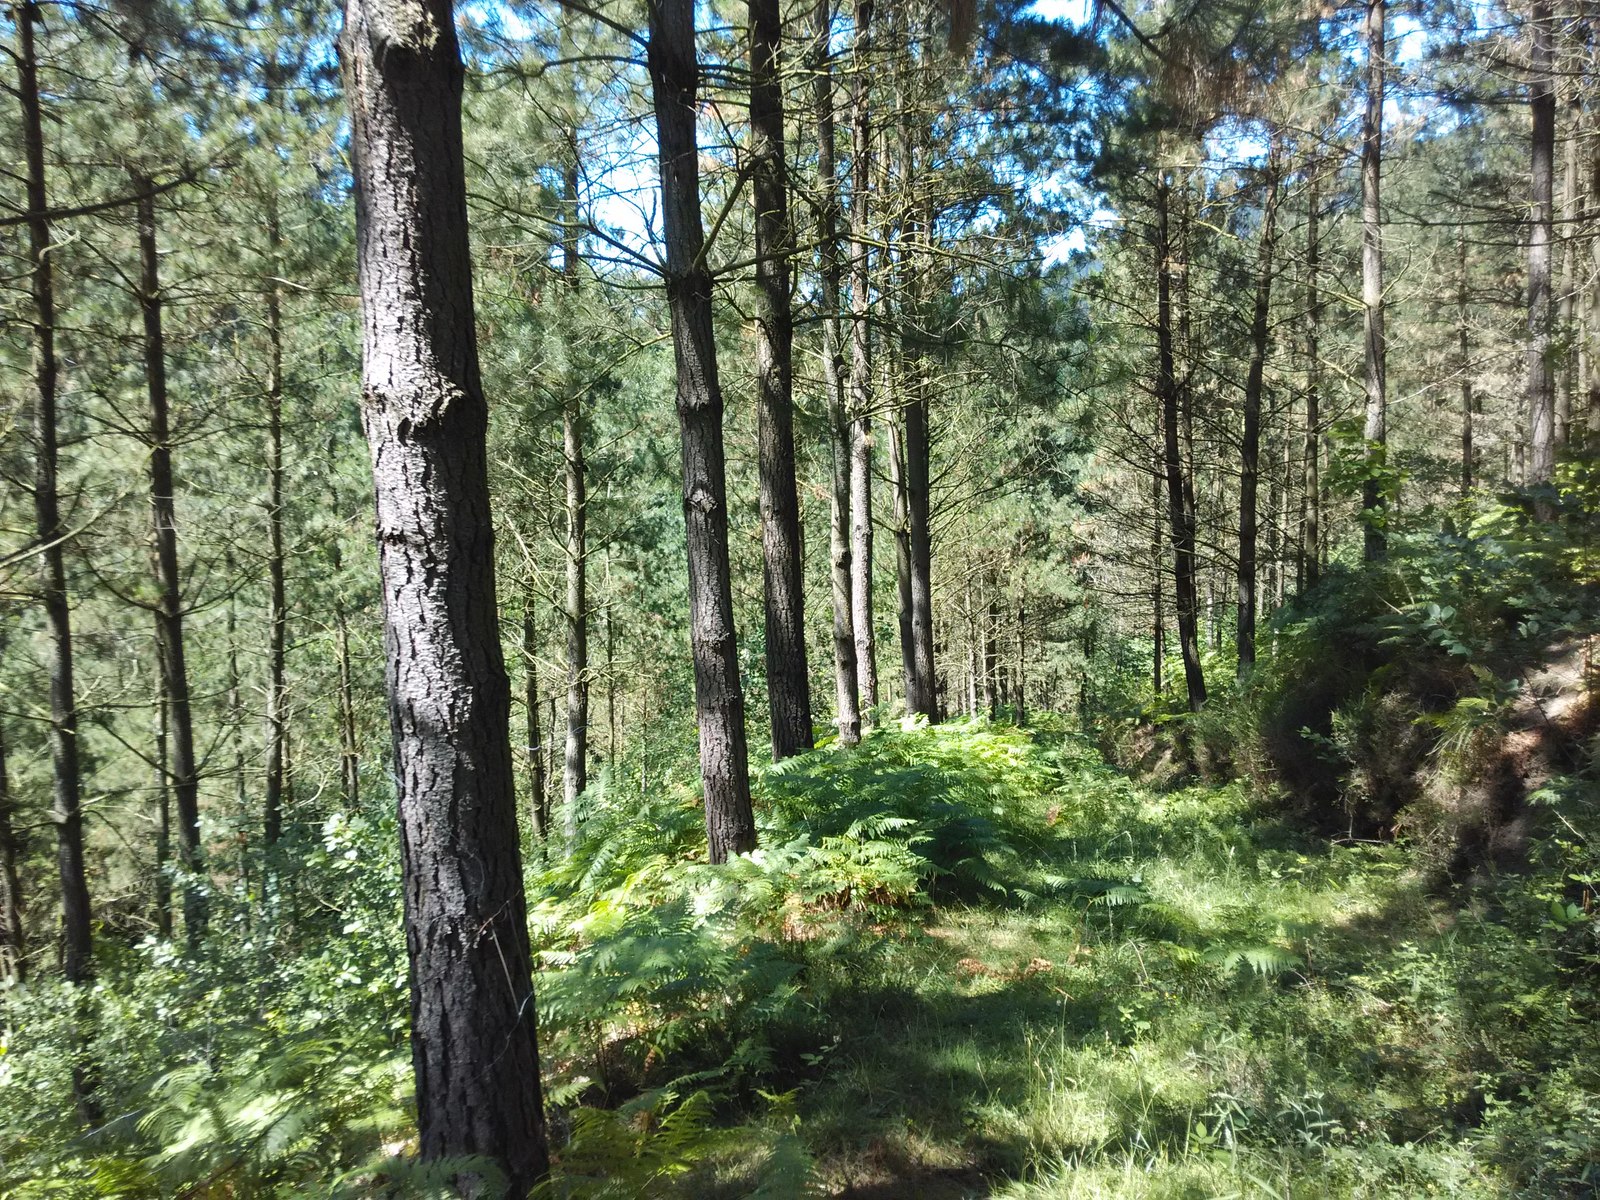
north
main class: Woodland
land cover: Pine dominated coniferous woodland
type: exotic forest
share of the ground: > 75 %
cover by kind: coniferous forest trees 100 %
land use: Forestry
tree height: > 5 m
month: July
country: ES
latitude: 43.0903
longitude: -2.5704
